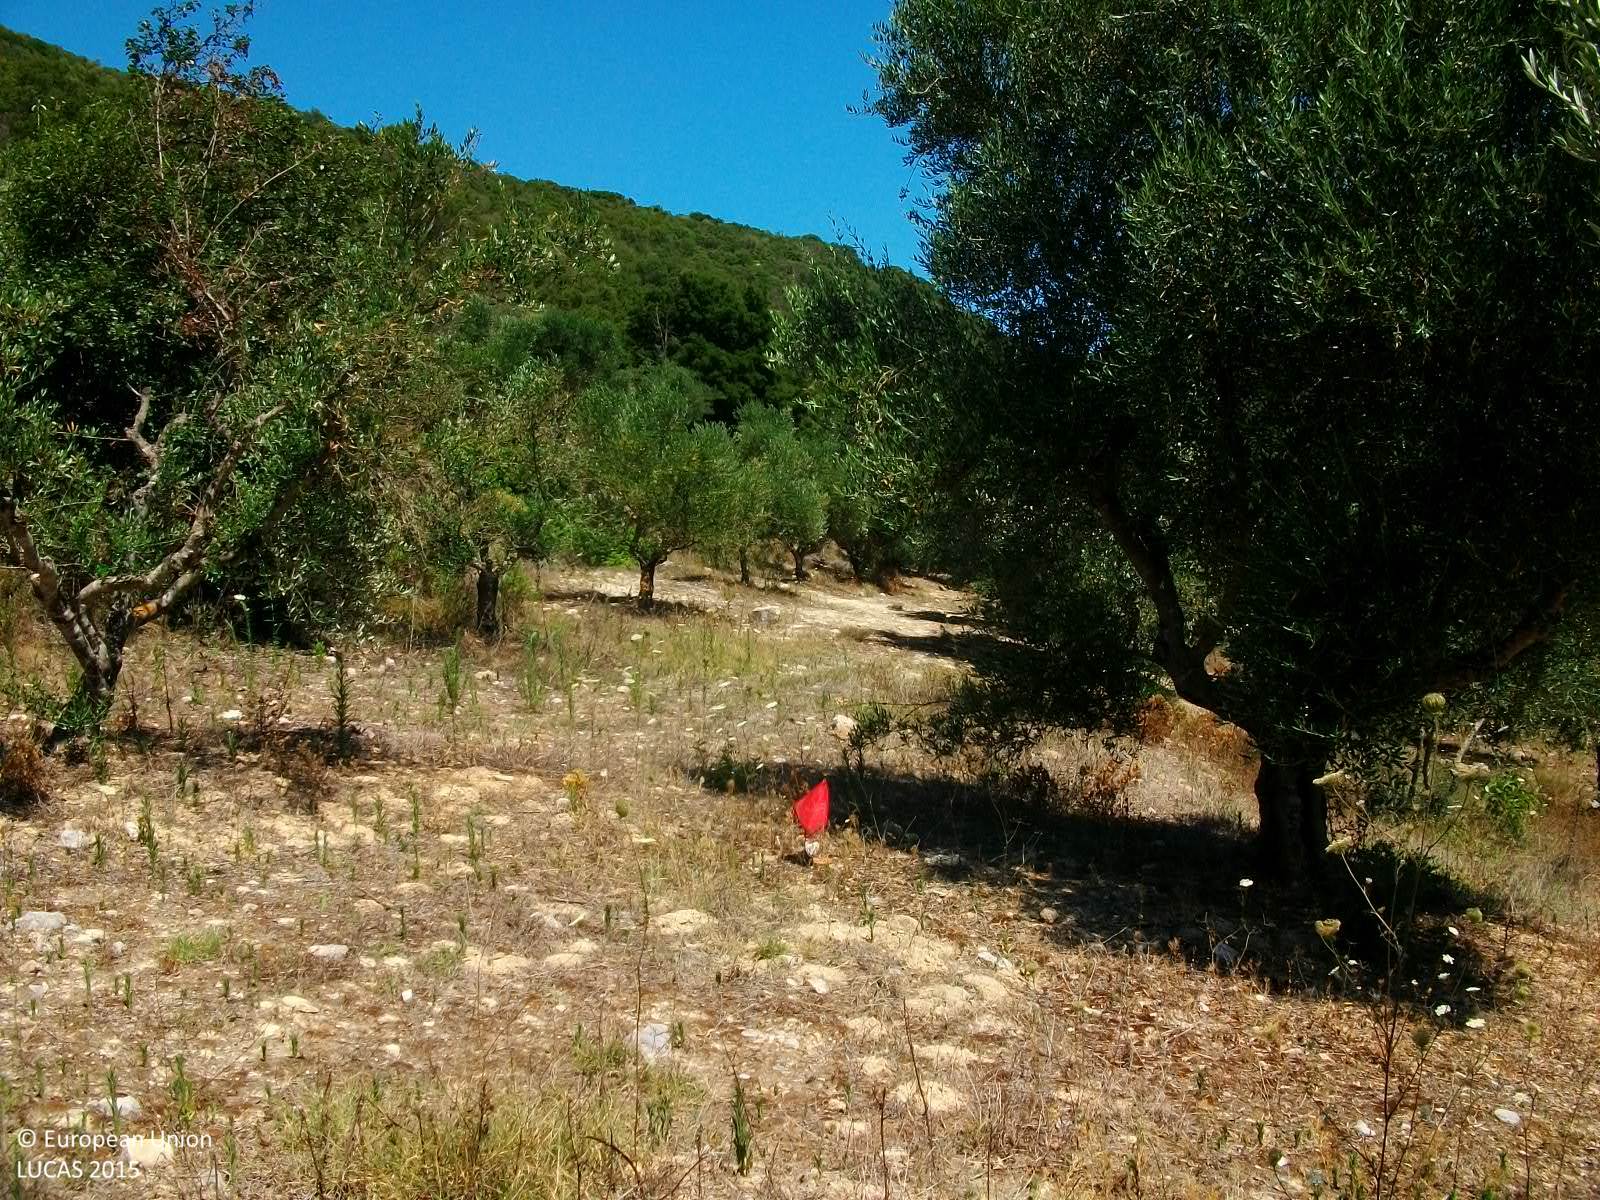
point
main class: Cropland
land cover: Olive groves
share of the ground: 10 - 25 %
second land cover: Spontaneously vegetated surfaces
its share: 50 - 75 %
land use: Agriculture (excluding fallow land and kitchen gardens)
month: July
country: GR
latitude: 36.8544
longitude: 21.8720
